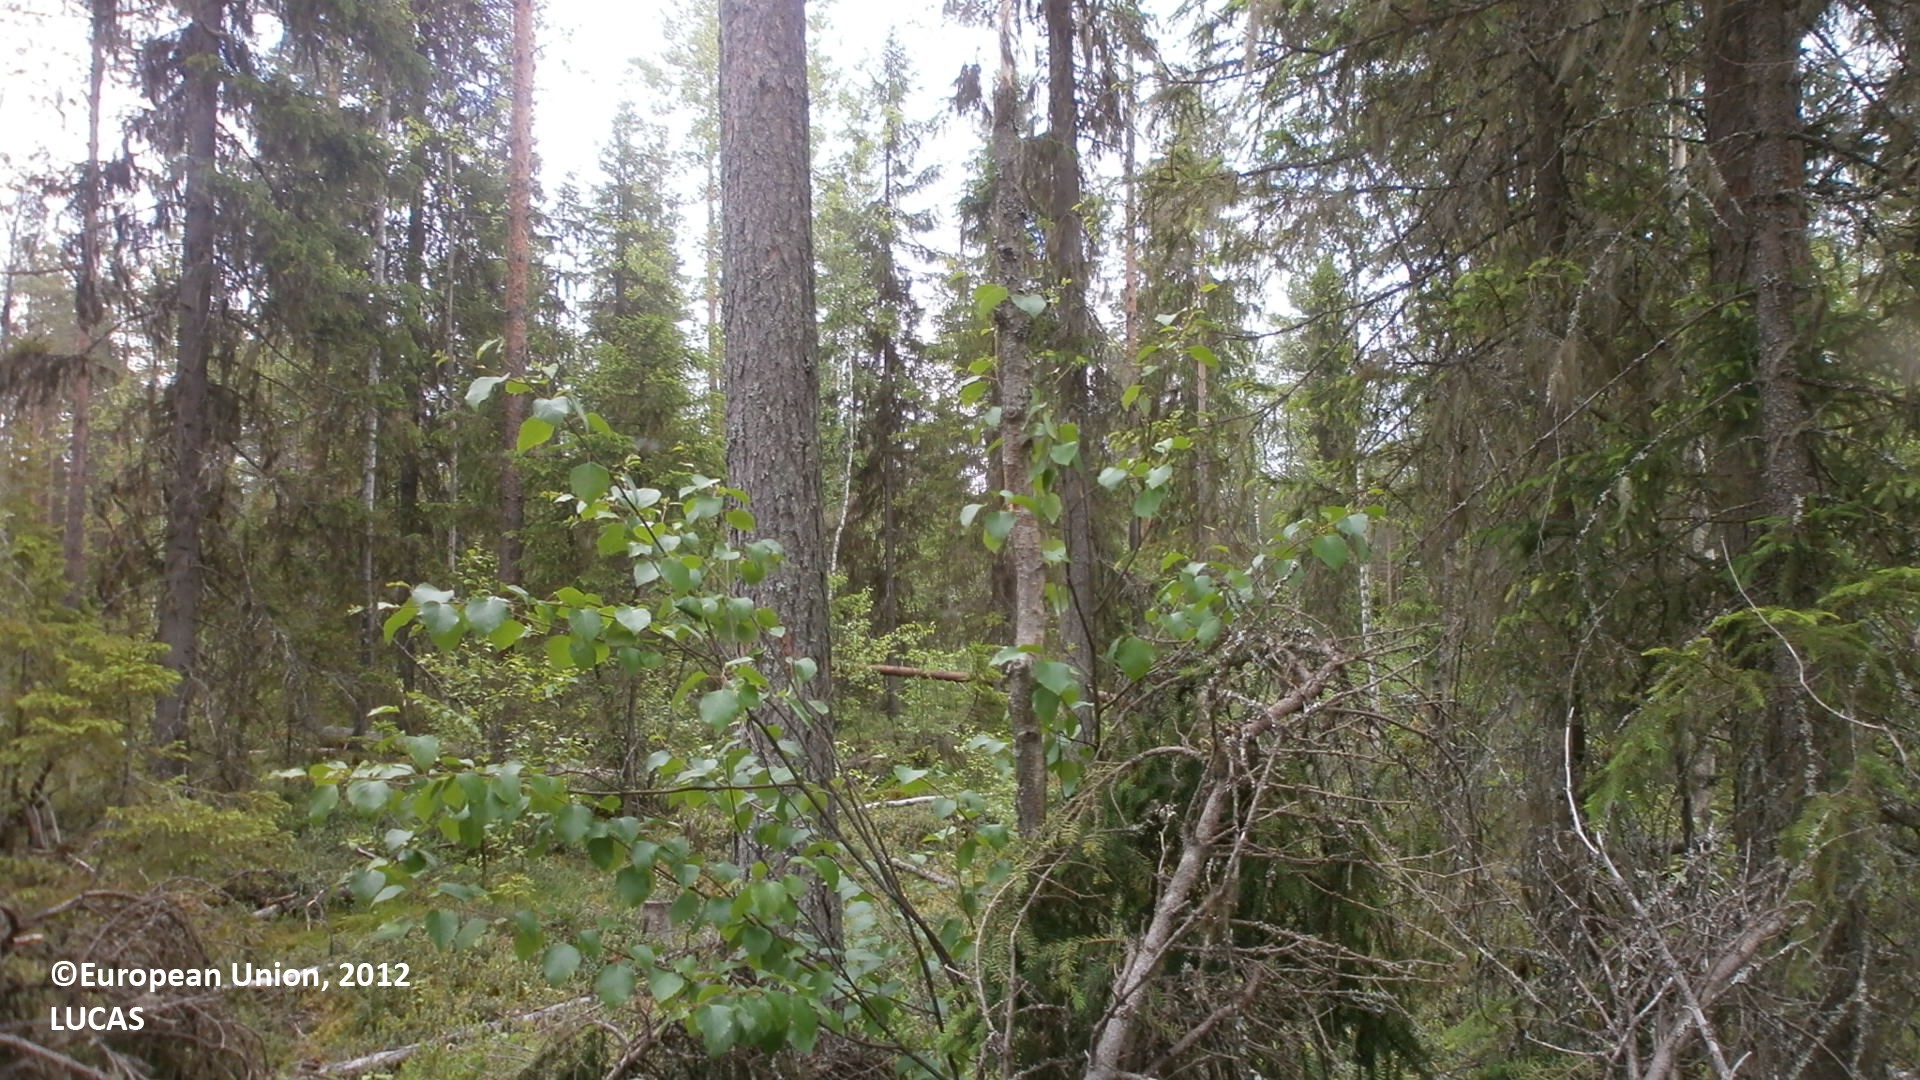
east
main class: Woodland
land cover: Other coniferous woodland
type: boreal forest
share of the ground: 50 - 75 %
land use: Forestry
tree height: > 5 m
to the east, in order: Other coniferous woodland; Pine dominated coniferous woodland; Ditches and canals; Pine dominated mixed woodland; Spruce dominated coniferous woodland; Ditches and canals; Spruce dominated coniferous woodland
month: June
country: FI
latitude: 64.2119
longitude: 25.7779
